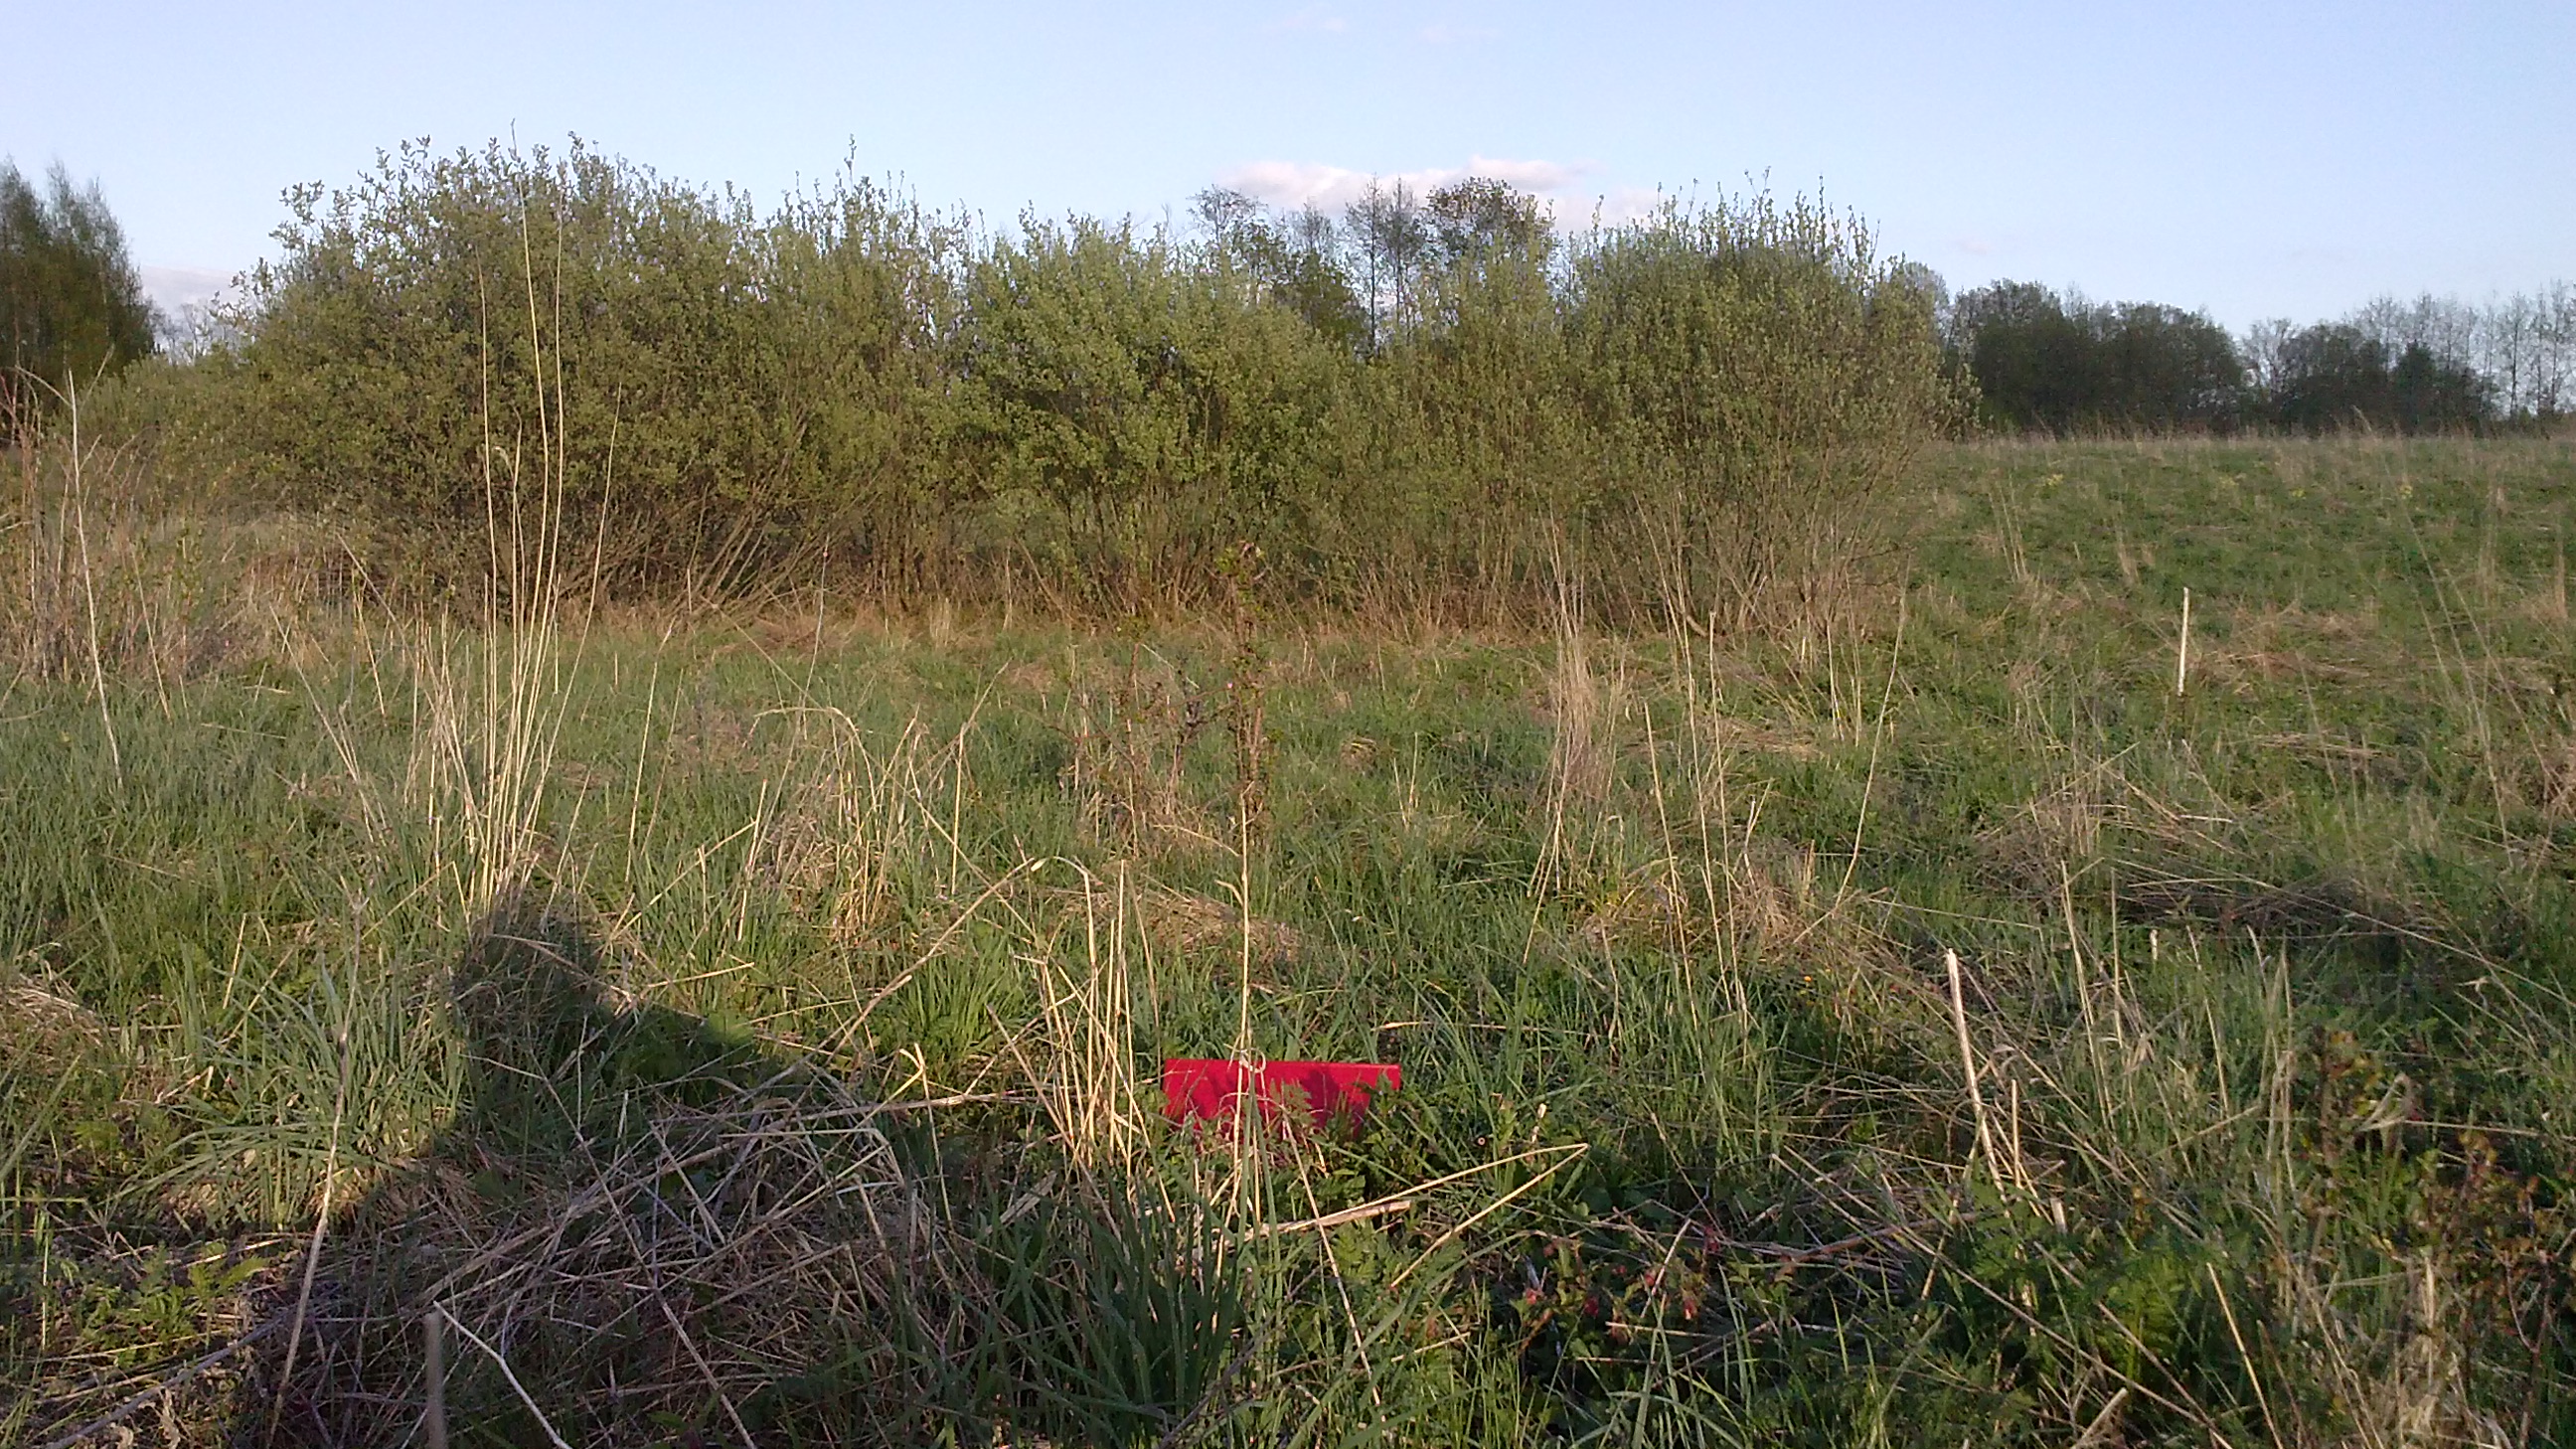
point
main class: Grassland
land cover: Grassland without tree/shrub cover
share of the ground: > 75 %
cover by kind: herbaceous plants 100 %
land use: Agriculture (excluding fallow land and kitchen gardens)
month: May
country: LV
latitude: 56.1142
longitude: 27.2357
